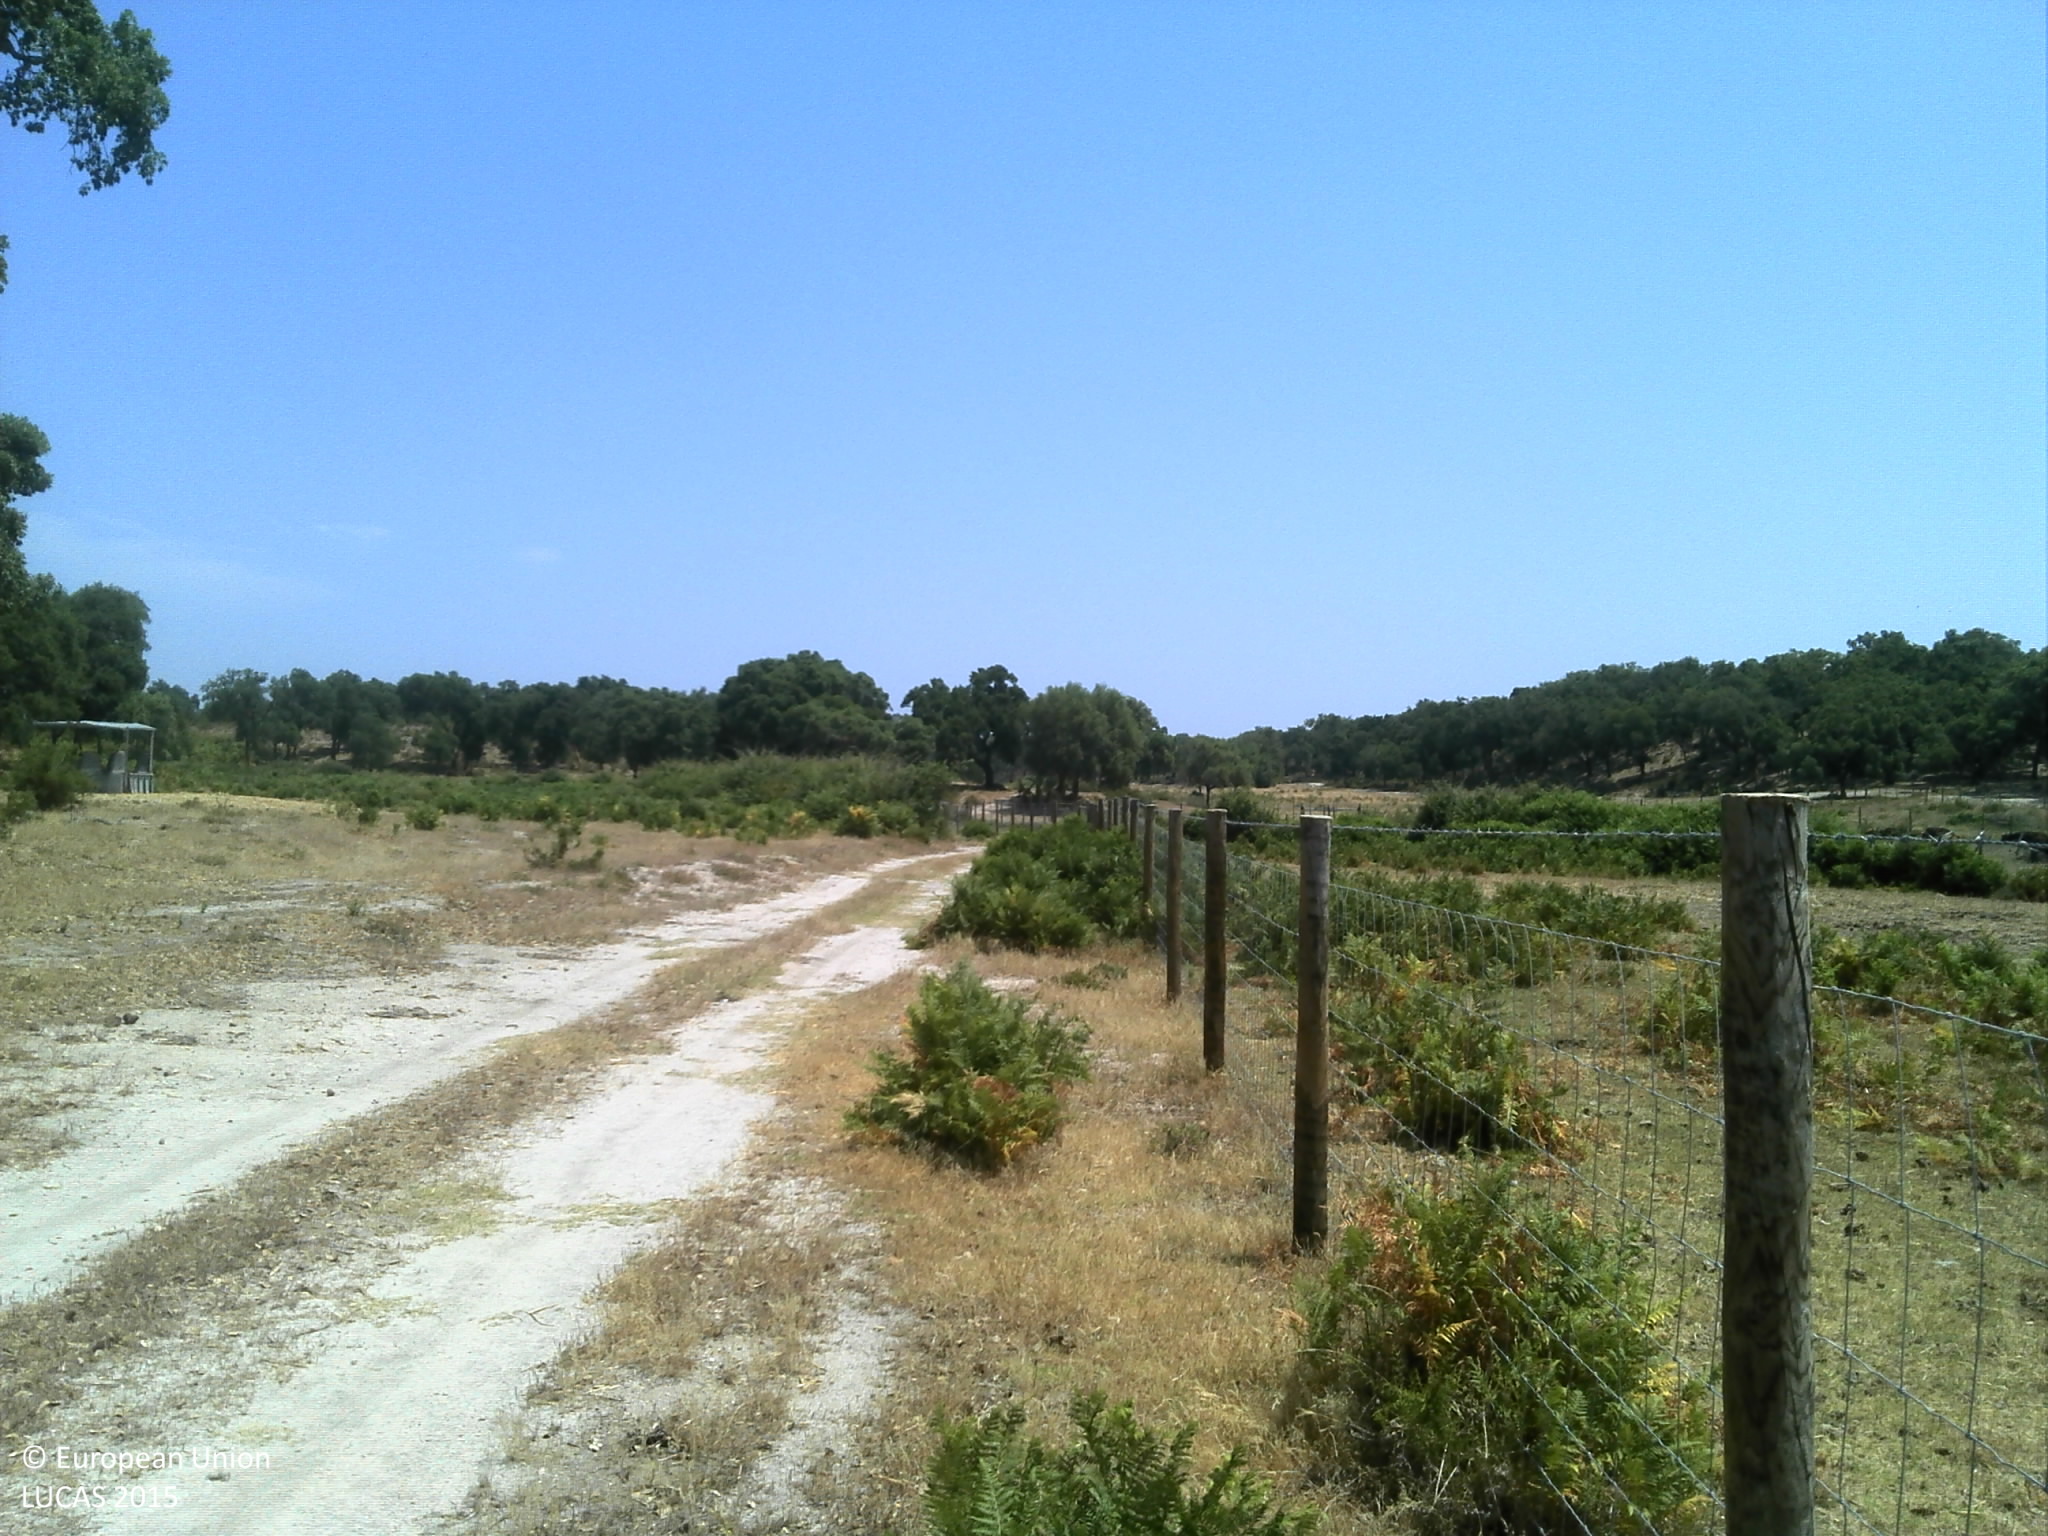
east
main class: Grassland
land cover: Grassland without tree/shrub cover
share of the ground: 50 - 75 %
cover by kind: herbaceous plants 75 %, unconsolidated bare surface 25 %
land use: Agriculture (excluding fallow land and kitchen gardens)
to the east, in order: Grassland without tree/shrub cover; Fences; Grassland without tree/shrub cover; Shruby margins; Grassland without tree/shrub cover; Fences; Tracks; Broadleaved woodland
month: June
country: PT
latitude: 39.3914
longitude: -7.9483
